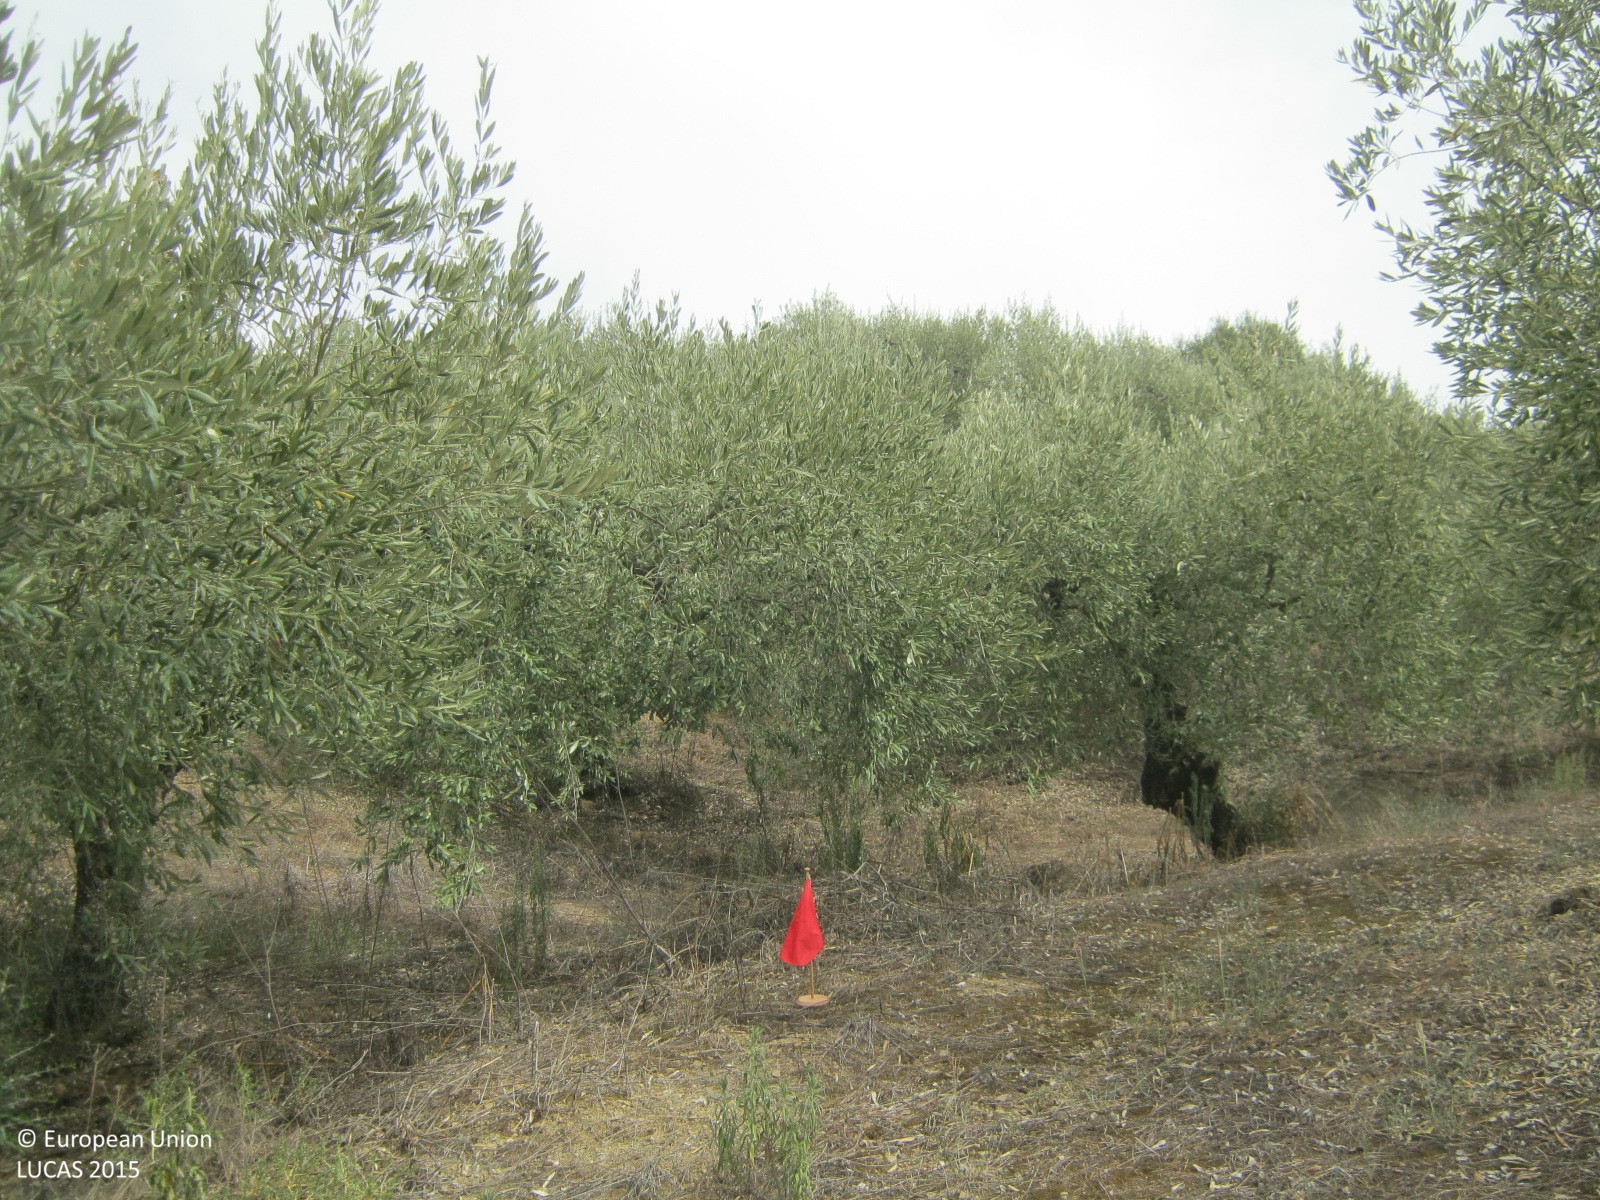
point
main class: Cropland
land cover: Olive groves
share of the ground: > 75 %
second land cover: Spontaneously vegetated surfaces
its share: > 75 %
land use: Agriculture (excluding fallow land and kitchen gardens)
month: September
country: GR
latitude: 39.1281
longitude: 21.0672
